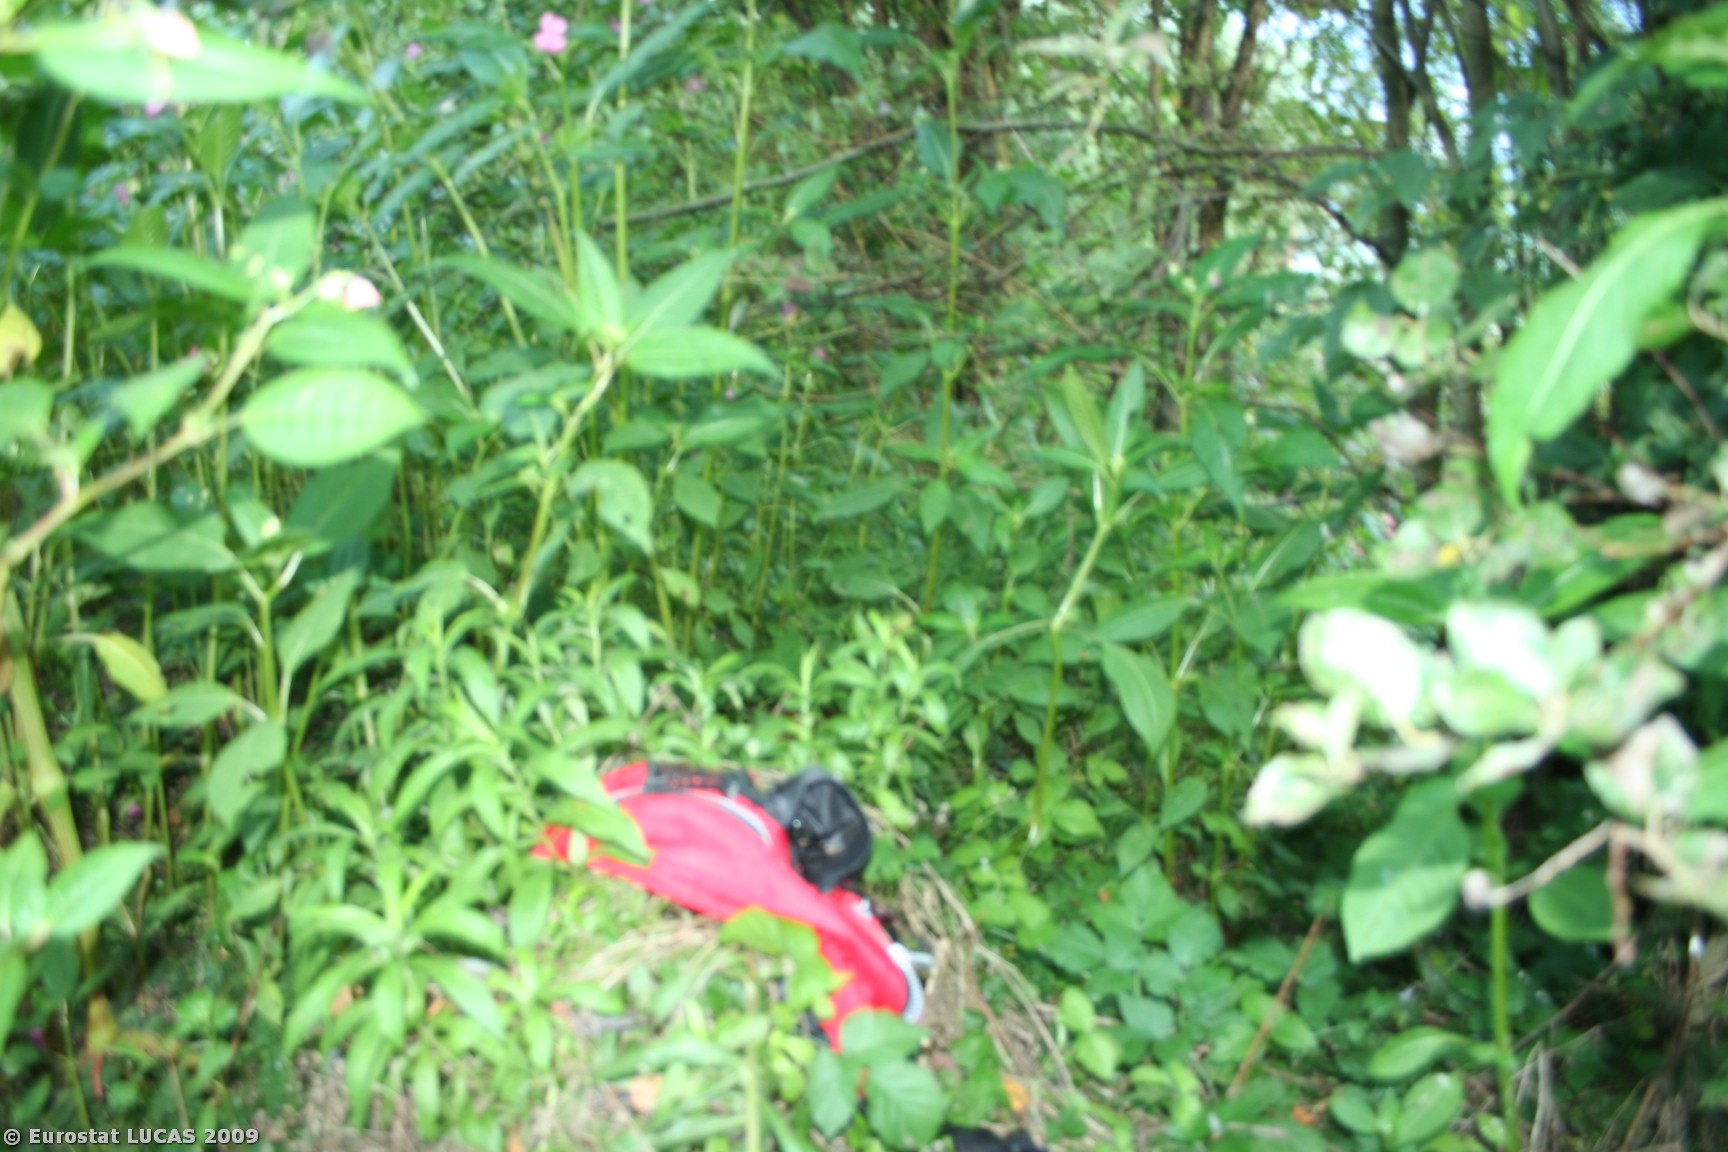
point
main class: Shrubland
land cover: Shrubland without tree cover
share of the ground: > 75 %
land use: Unused
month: August
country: AT
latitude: 47.4507
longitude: 11.9216
